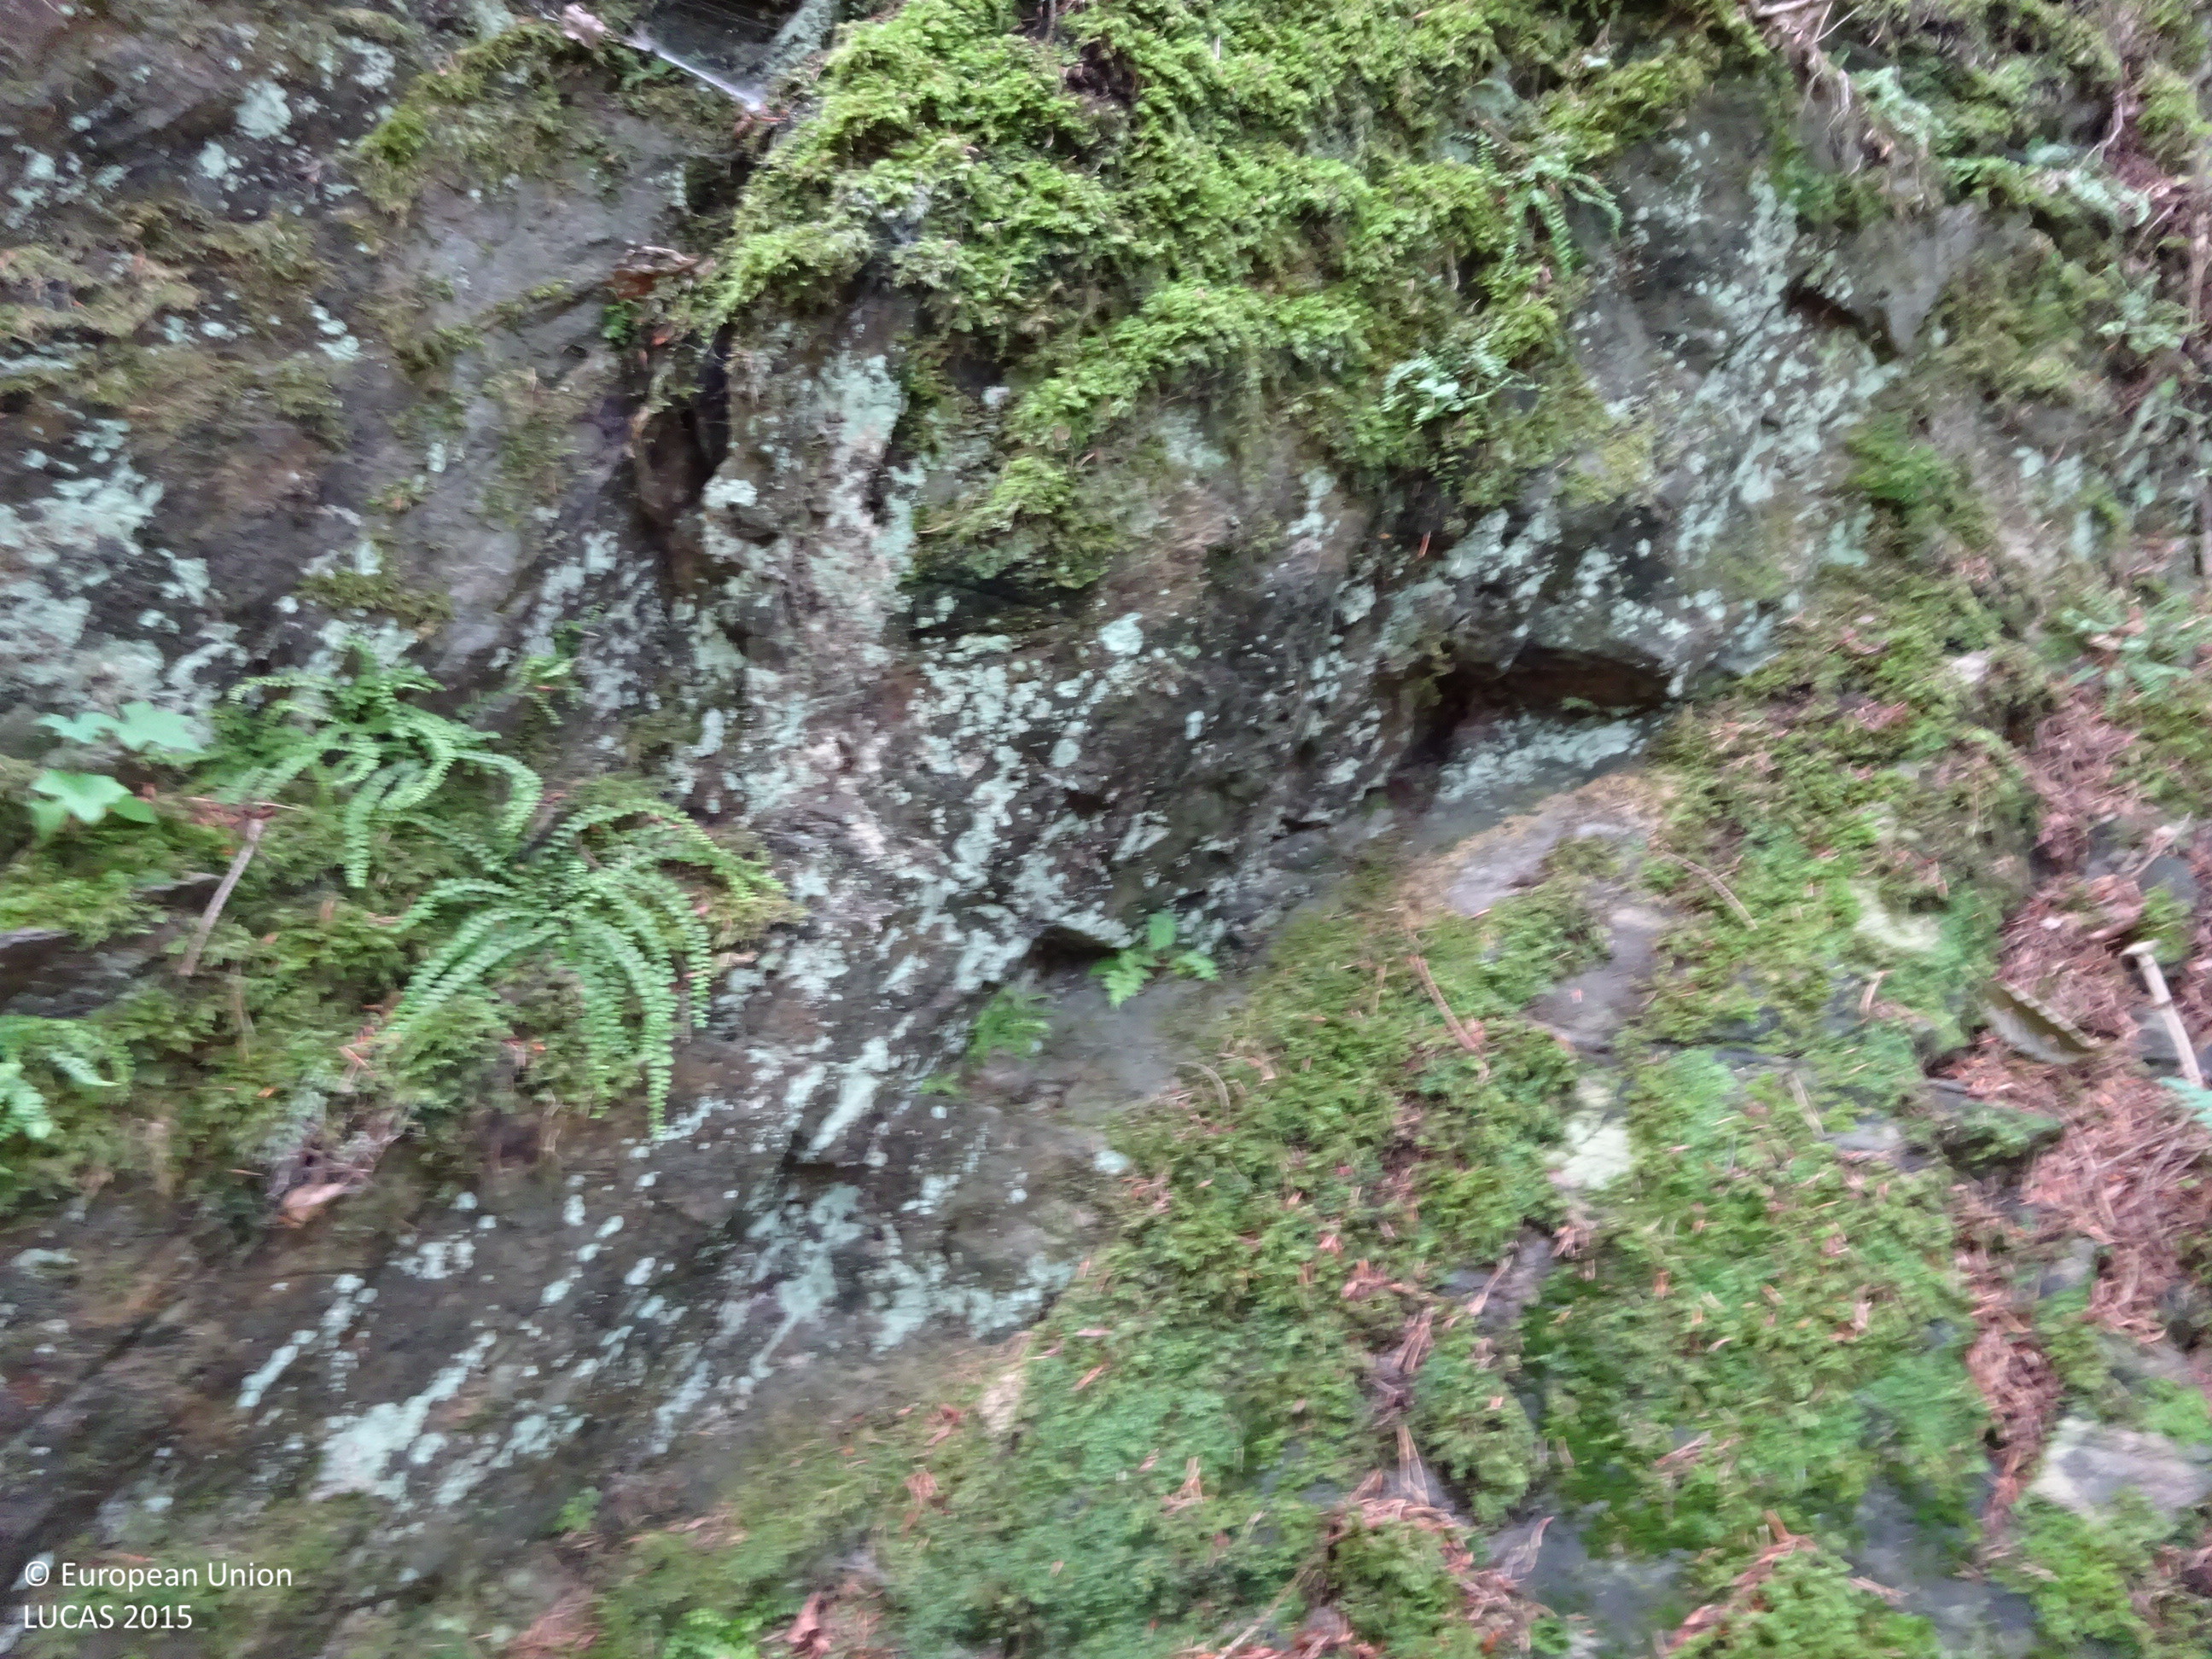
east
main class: Woodland
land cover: Spruce dominated mixed woodland
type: mountainous beech forest
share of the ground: > 75 %
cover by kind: broadleaved forest trees 70 %, coniferous forest trees 25 %, consolidated bare surface 5 %
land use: Forestry
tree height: > 5 m
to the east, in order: Spruce dominated mixed woodland; Rocks and stones; Spruce dominated mixed woodland; Broadleaved woodland; Spruce dominated mixed woodland; Rivers and streams; Spruce dominated mixed woodland
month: July
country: AT
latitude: 47.3702
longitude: 15.3902
